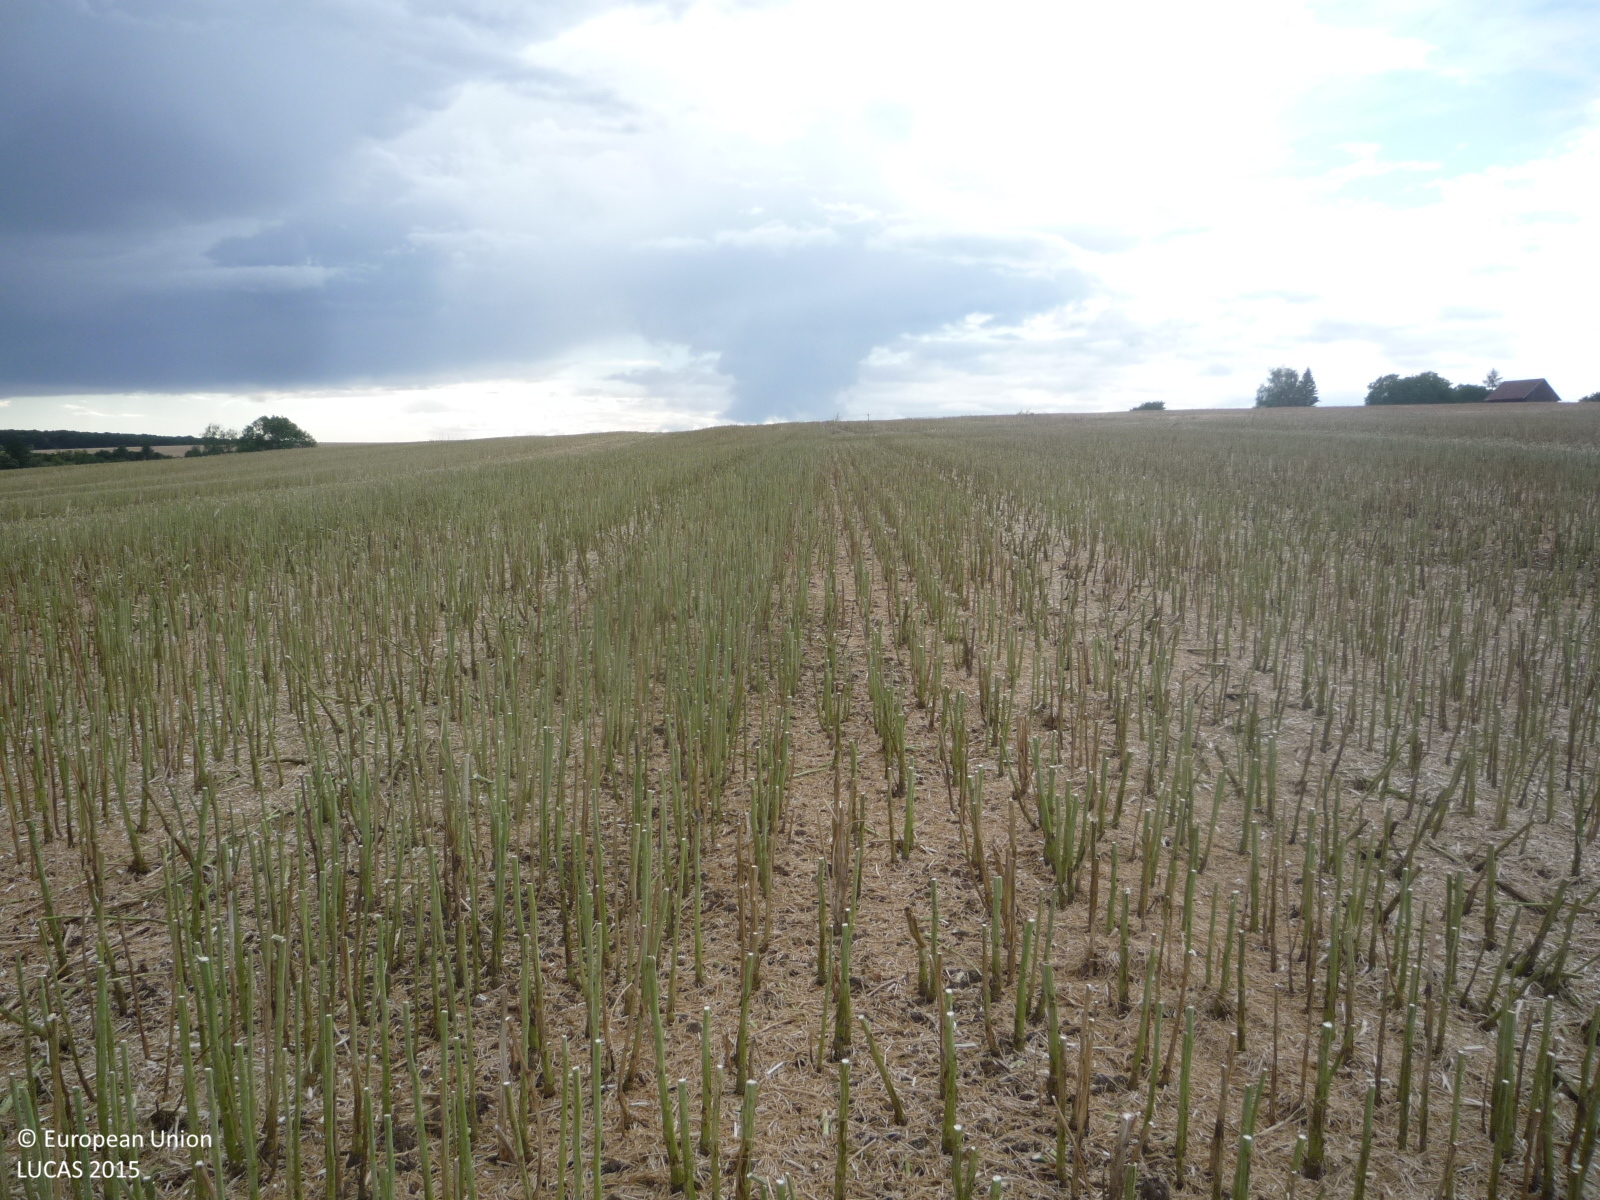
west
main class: Cropland
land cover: Rape and turnip rape
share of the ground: 50 - 75 %
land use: Agriculture (excluding fallow land and kitchen gardens)
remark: Harvested field
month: July
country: CZ
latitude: 50.3685
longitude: 15.2757
